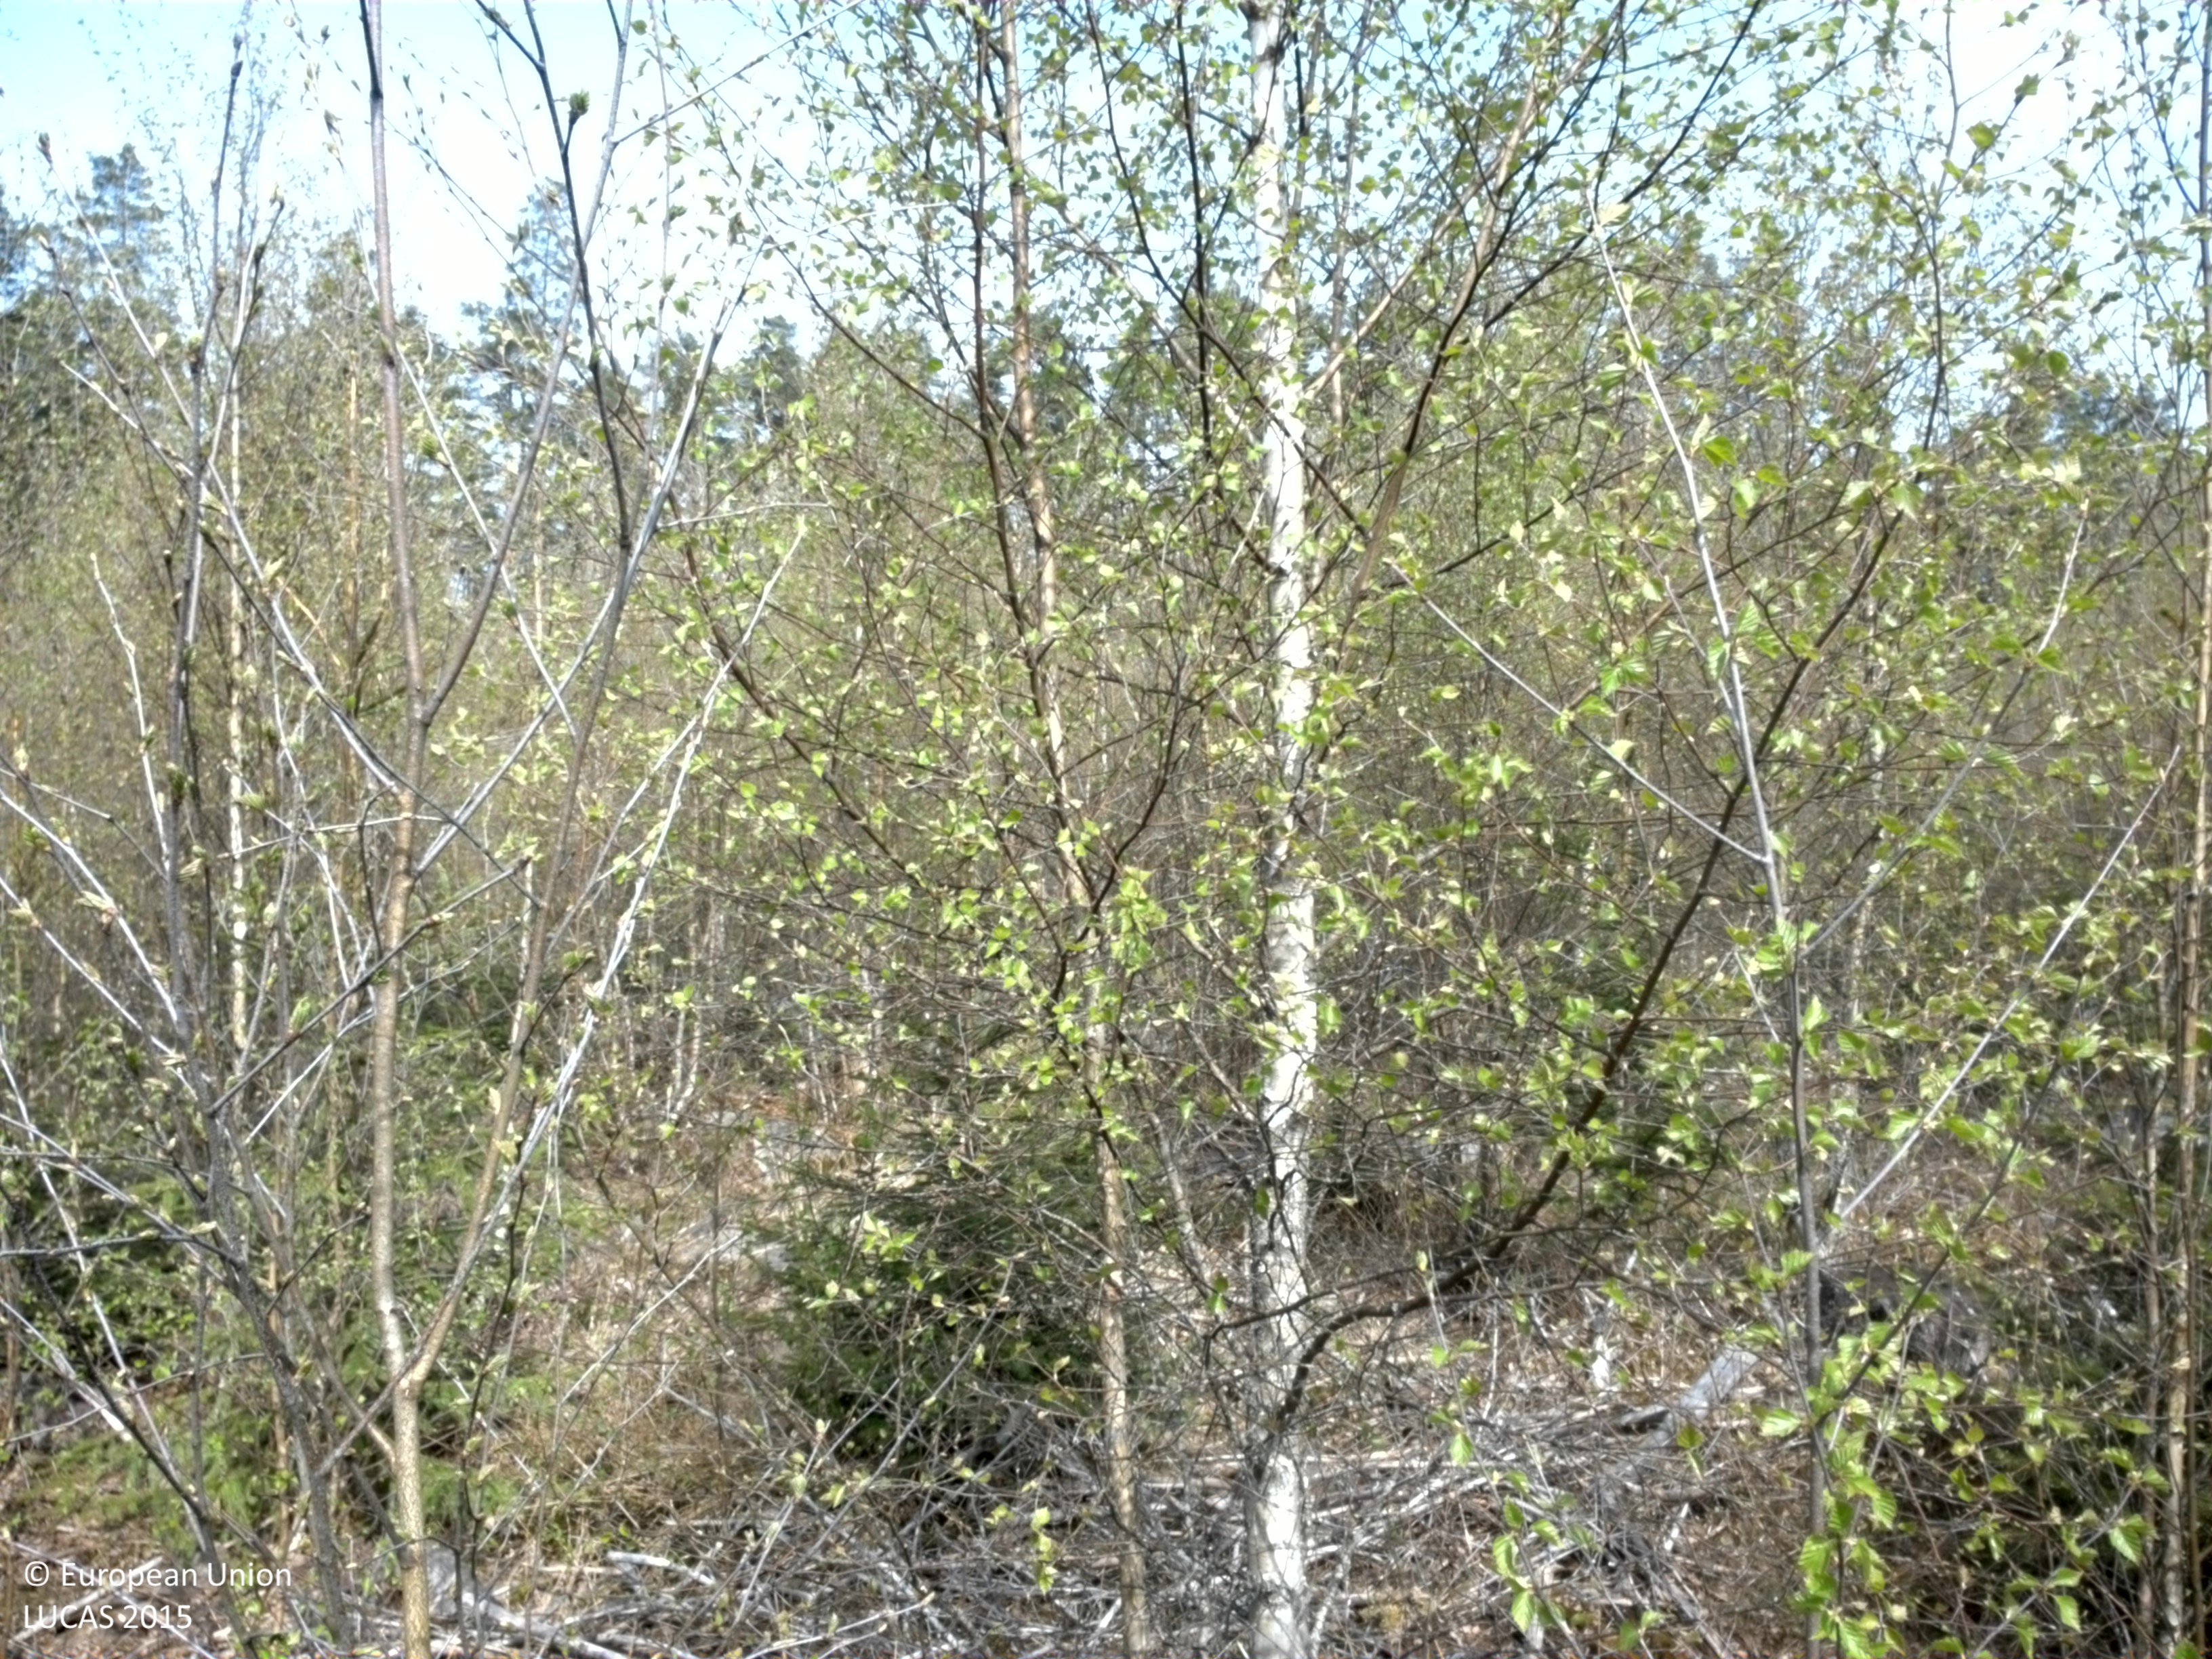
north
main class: Woodland
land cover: Broadleaved woodland
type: boreal forest
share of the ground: > 75 %
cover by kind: broadleaved forest trees 75 %, coniferous forest trees 15 %, shrubs 5 %, herbaceous plants 5 %
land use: Forestry
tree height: < 5 m
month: May
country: SE
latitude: 56.7995
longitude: 14.8278
